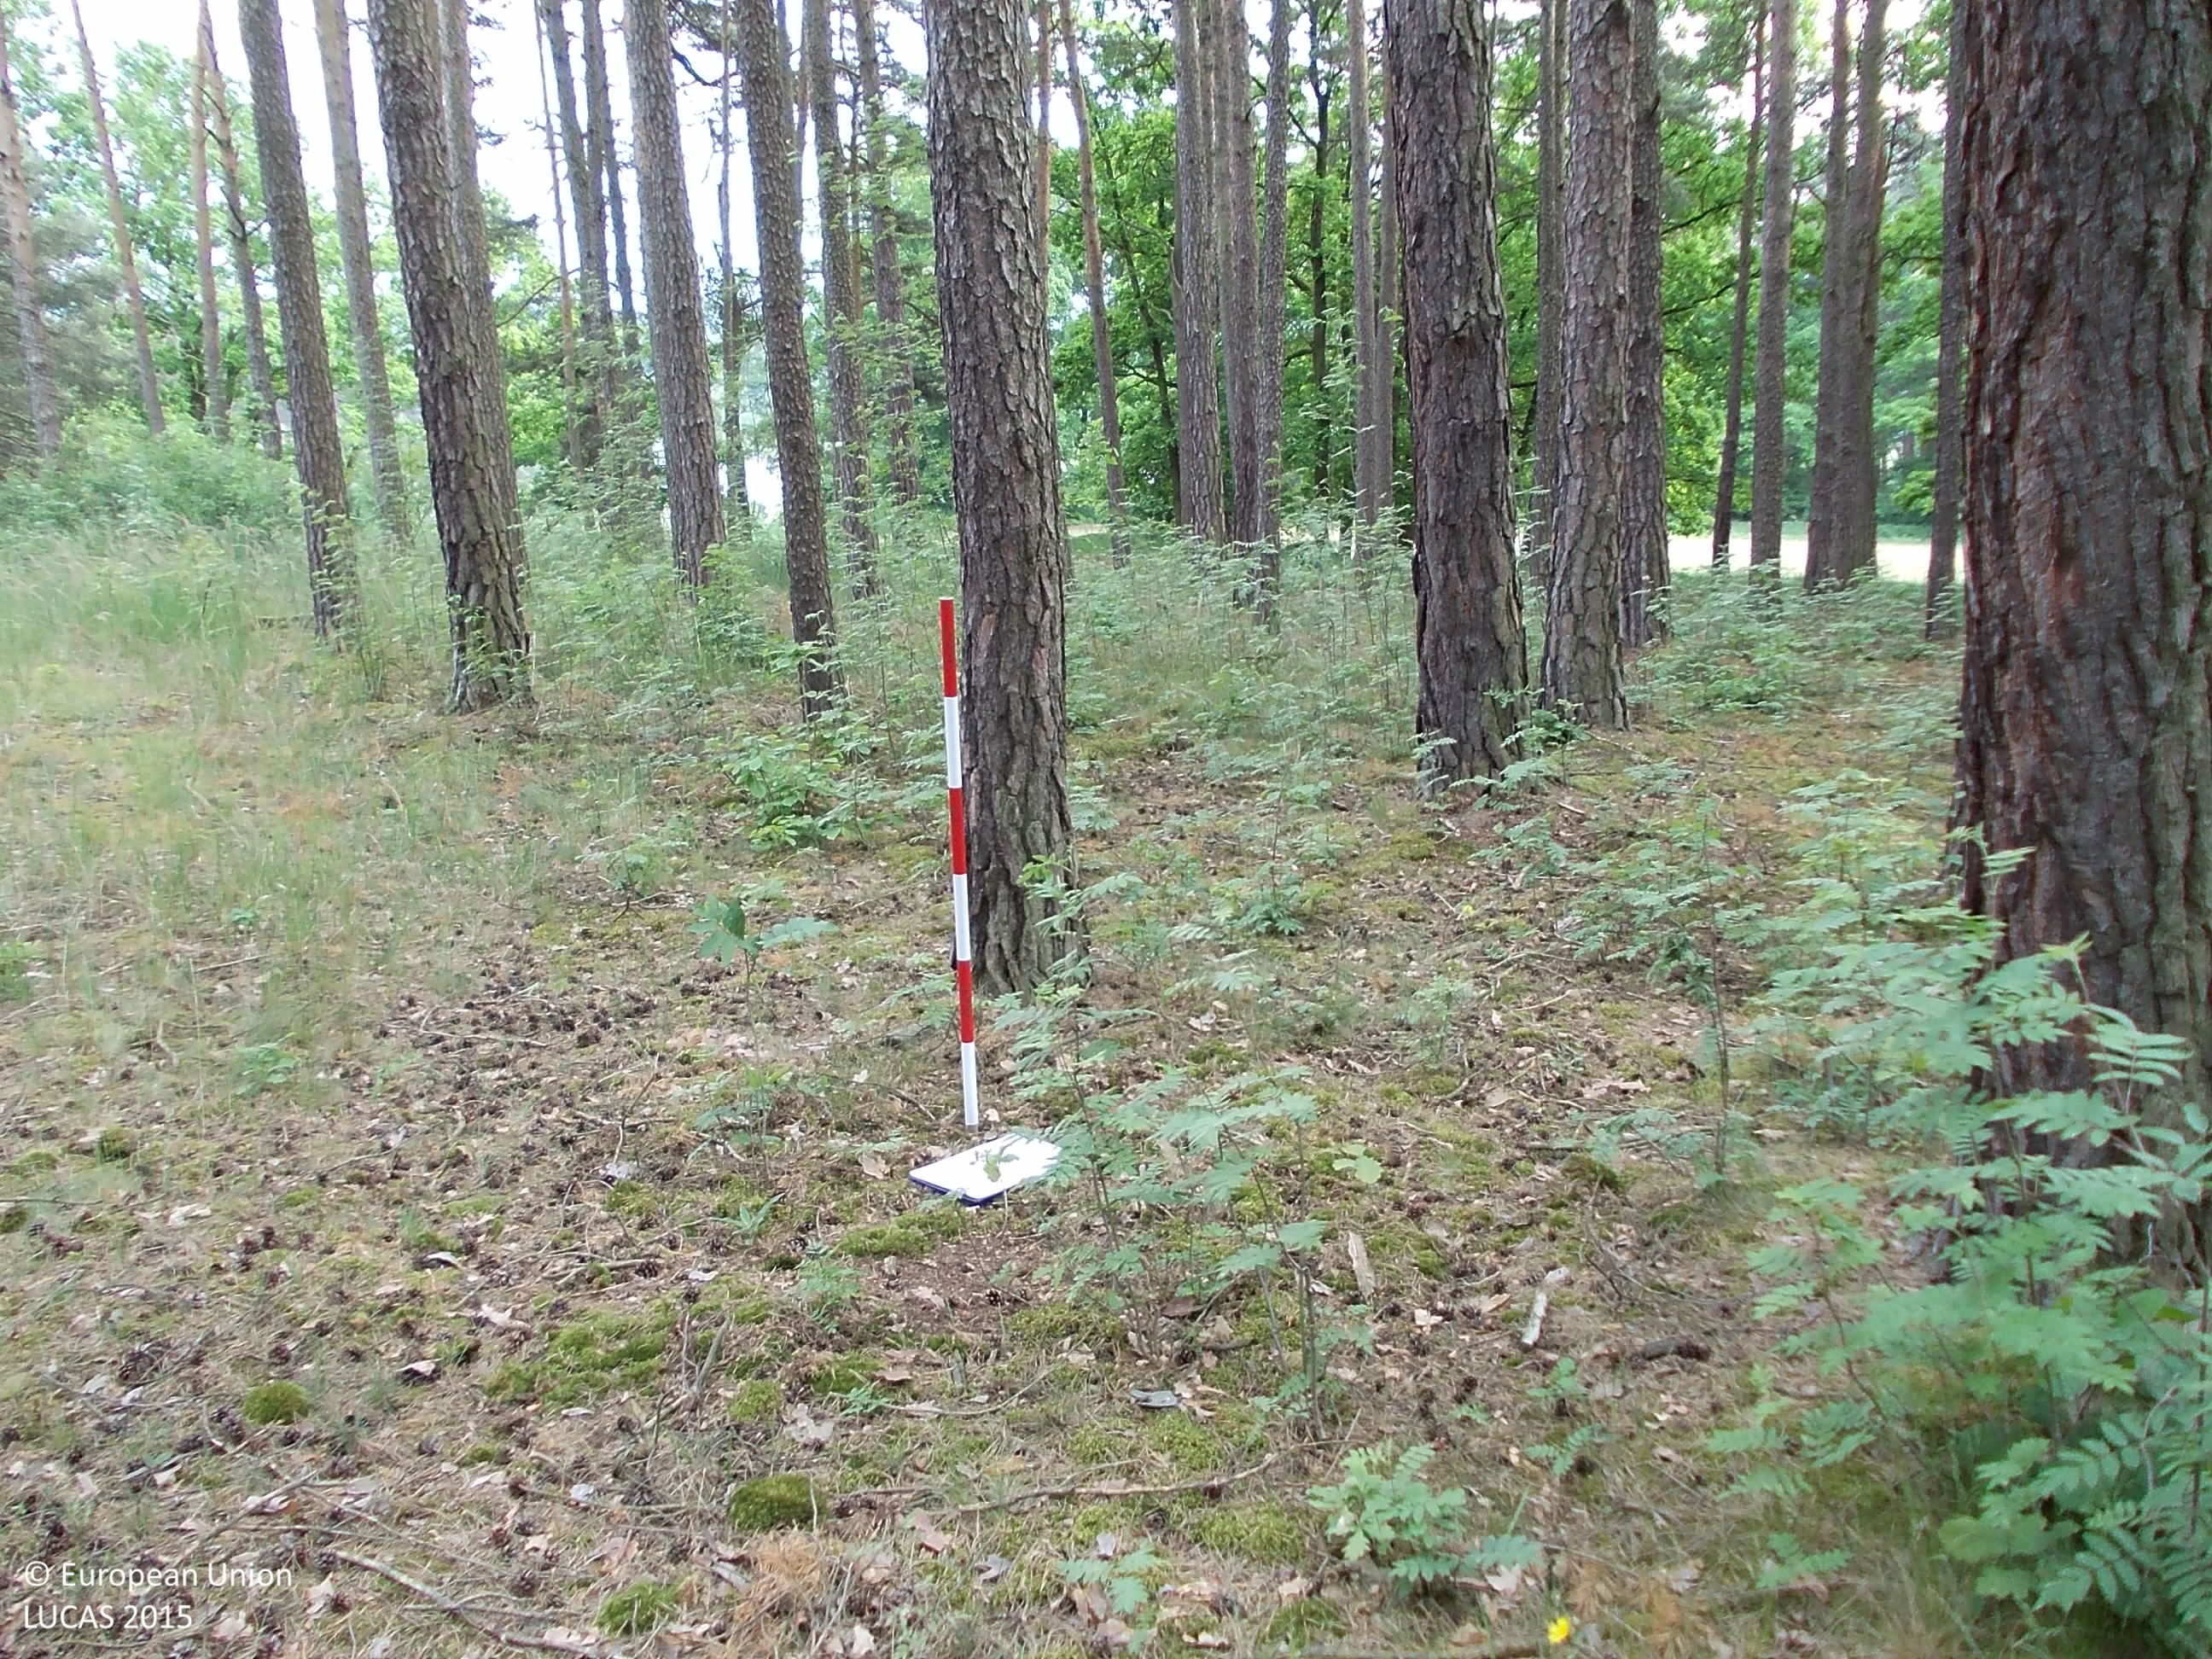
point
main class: Woodland
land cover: Pine dominated coniferous woodland
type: hemiboreal forest and nemoral coniferous forest and mixed broadleaved-coniferous forest
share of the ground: > 75 %
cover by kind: coniferous forest trees 90 %, broadleaved forest trees 10 %
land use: Forestry
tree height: > 5 m
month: May
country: CZ
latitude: 49.4011
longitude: 13.7899
